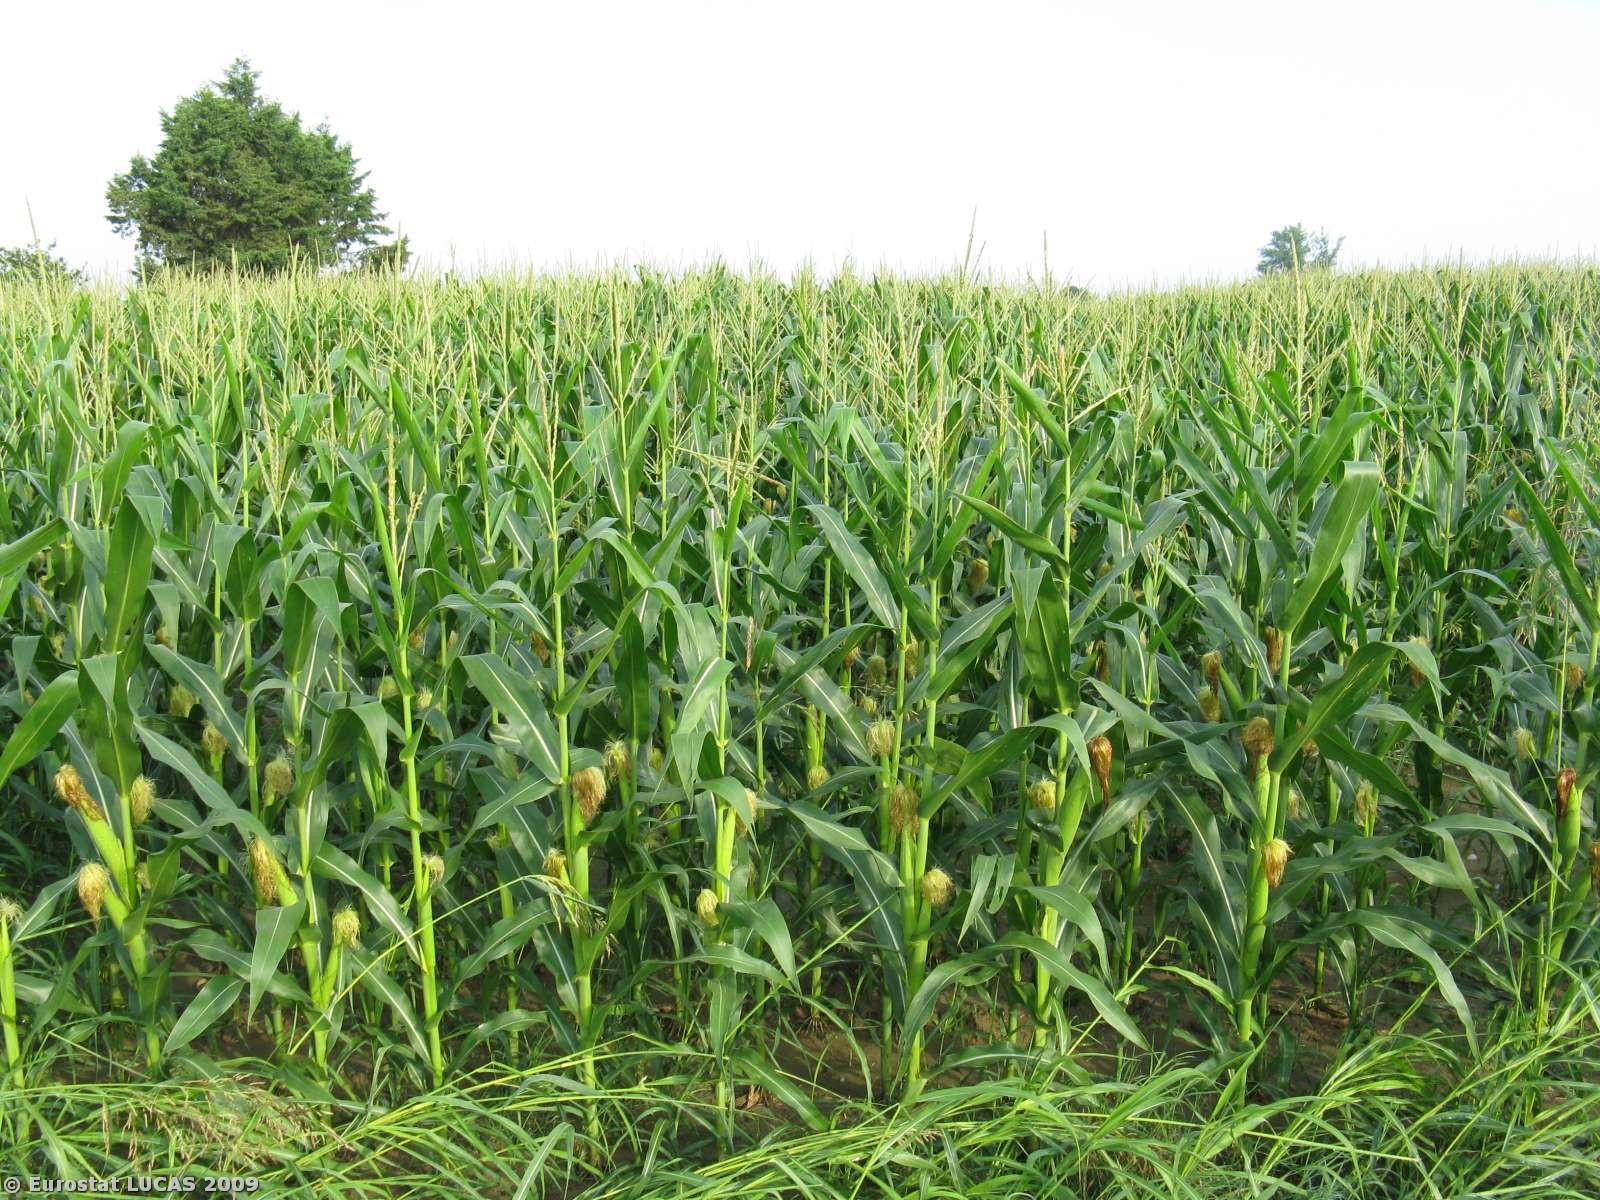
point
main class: Cropland
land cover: Maize
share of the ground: > 75 %
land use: Agriculture (excluding fallow land and kitchen gardens)
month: July
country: IT
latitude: 44.7330
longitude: 11.7265
